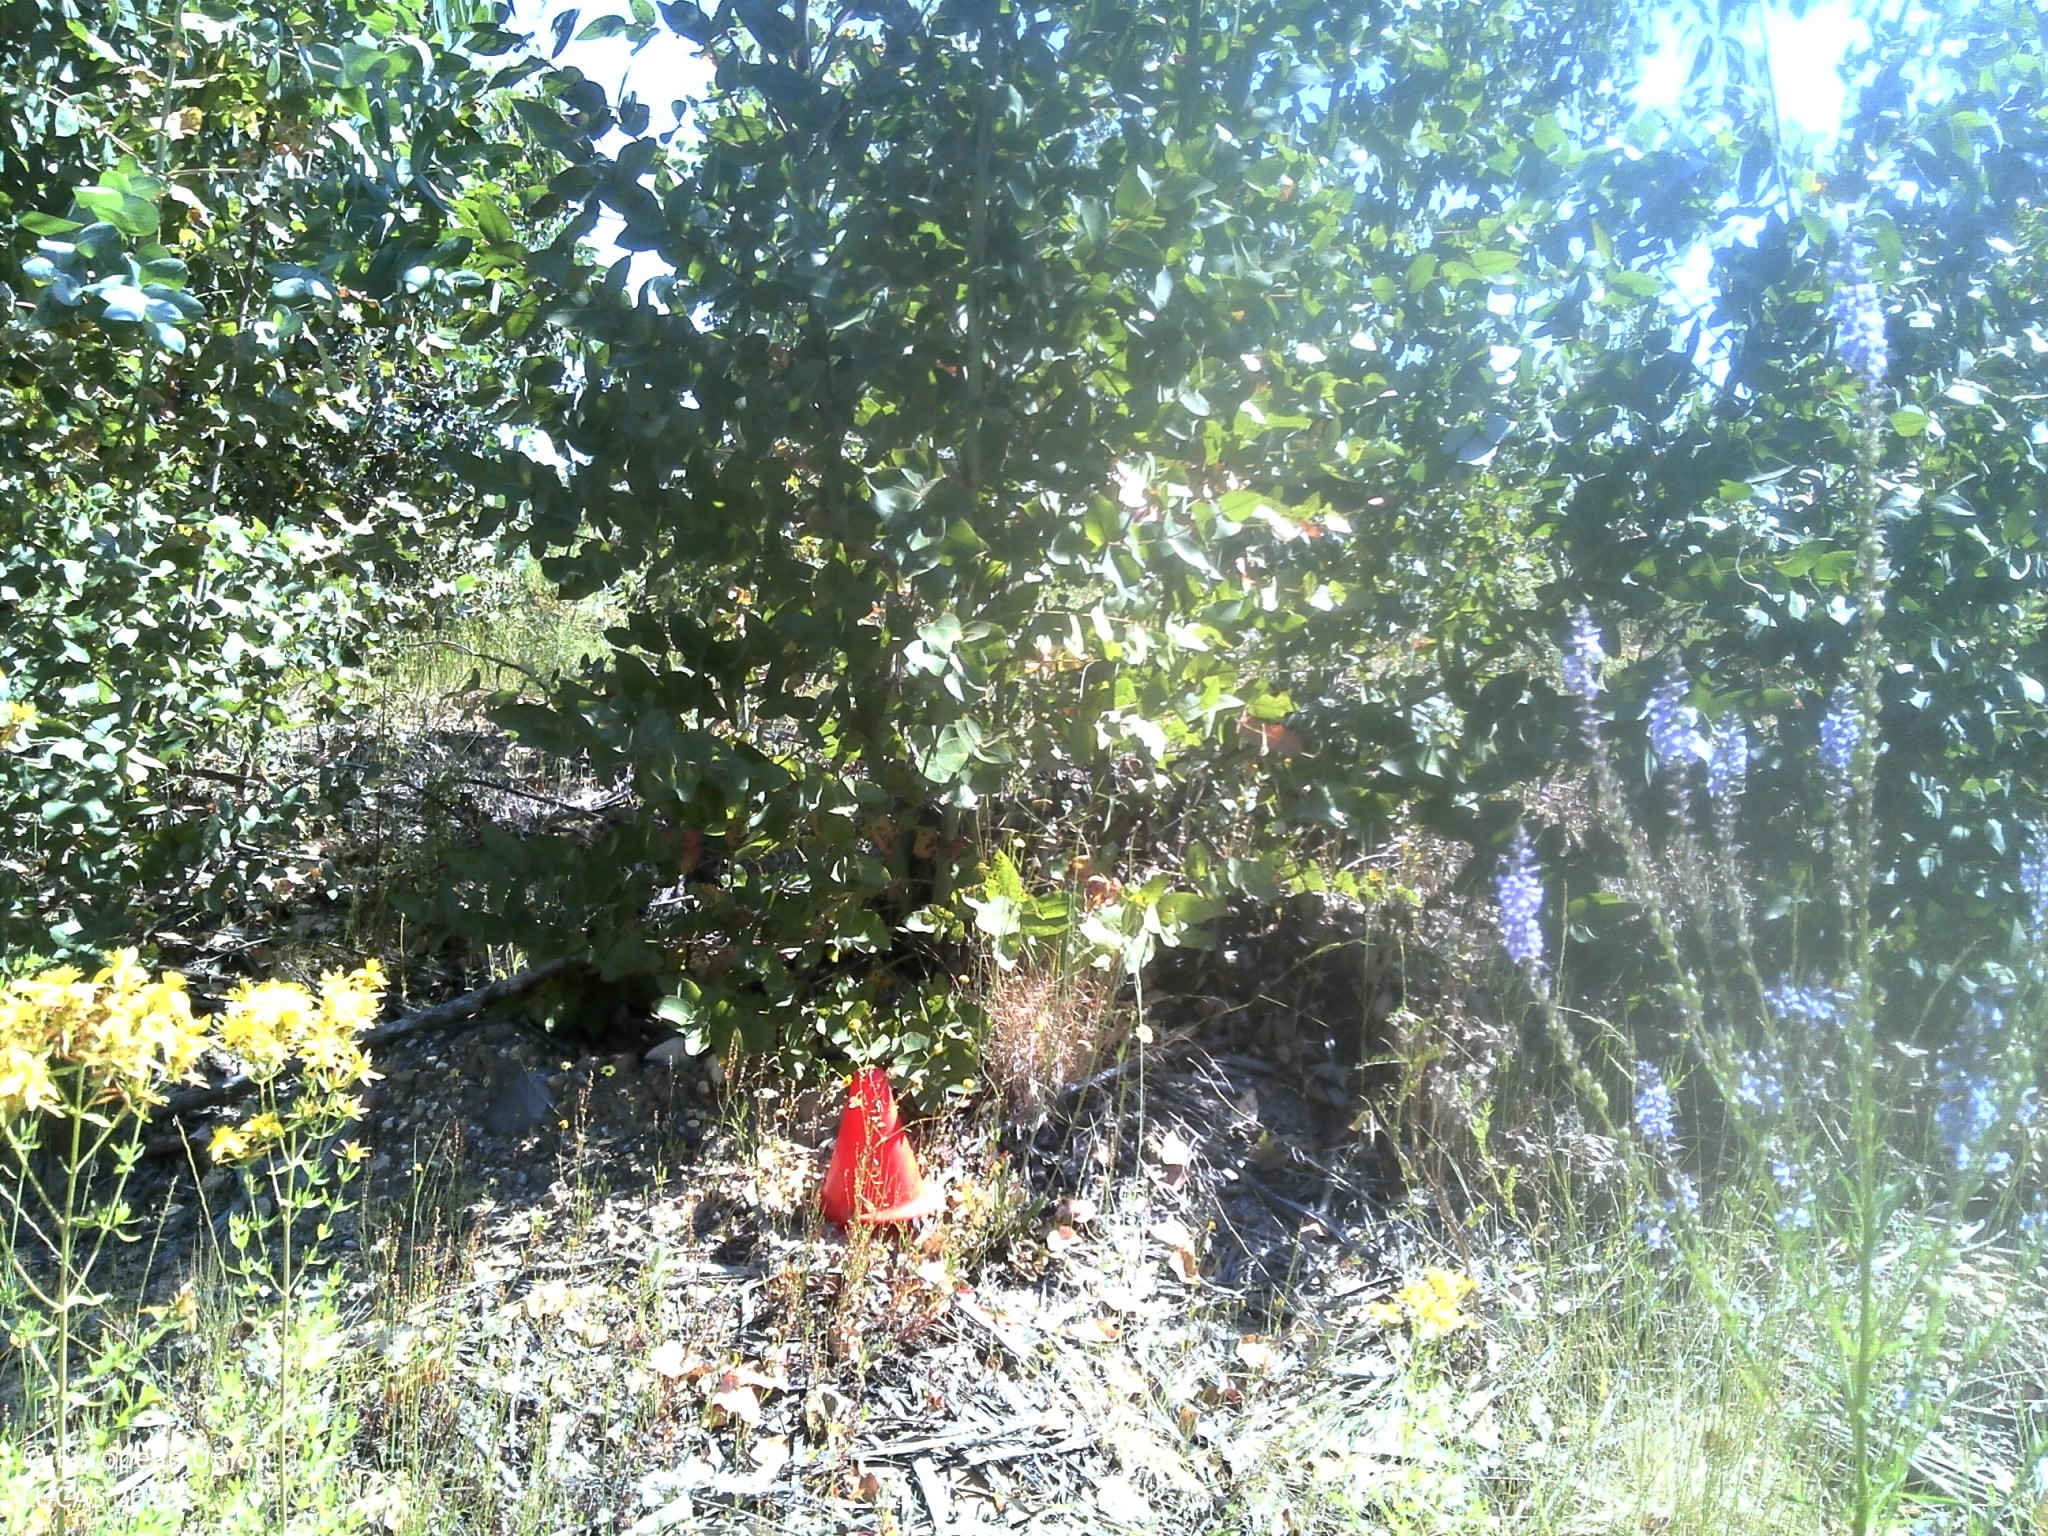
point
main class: Woodland
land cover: Broadleaved woodland
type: exotic forest
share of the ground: 50 - 75 %
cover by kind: broadleaved forest trees 70 %, herbaceous plants 15 %, unconsolidated bare surface 15 %
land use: Forestry
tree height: > 5 m
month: May
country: PT
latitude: 39.4323
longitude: -8.3177
